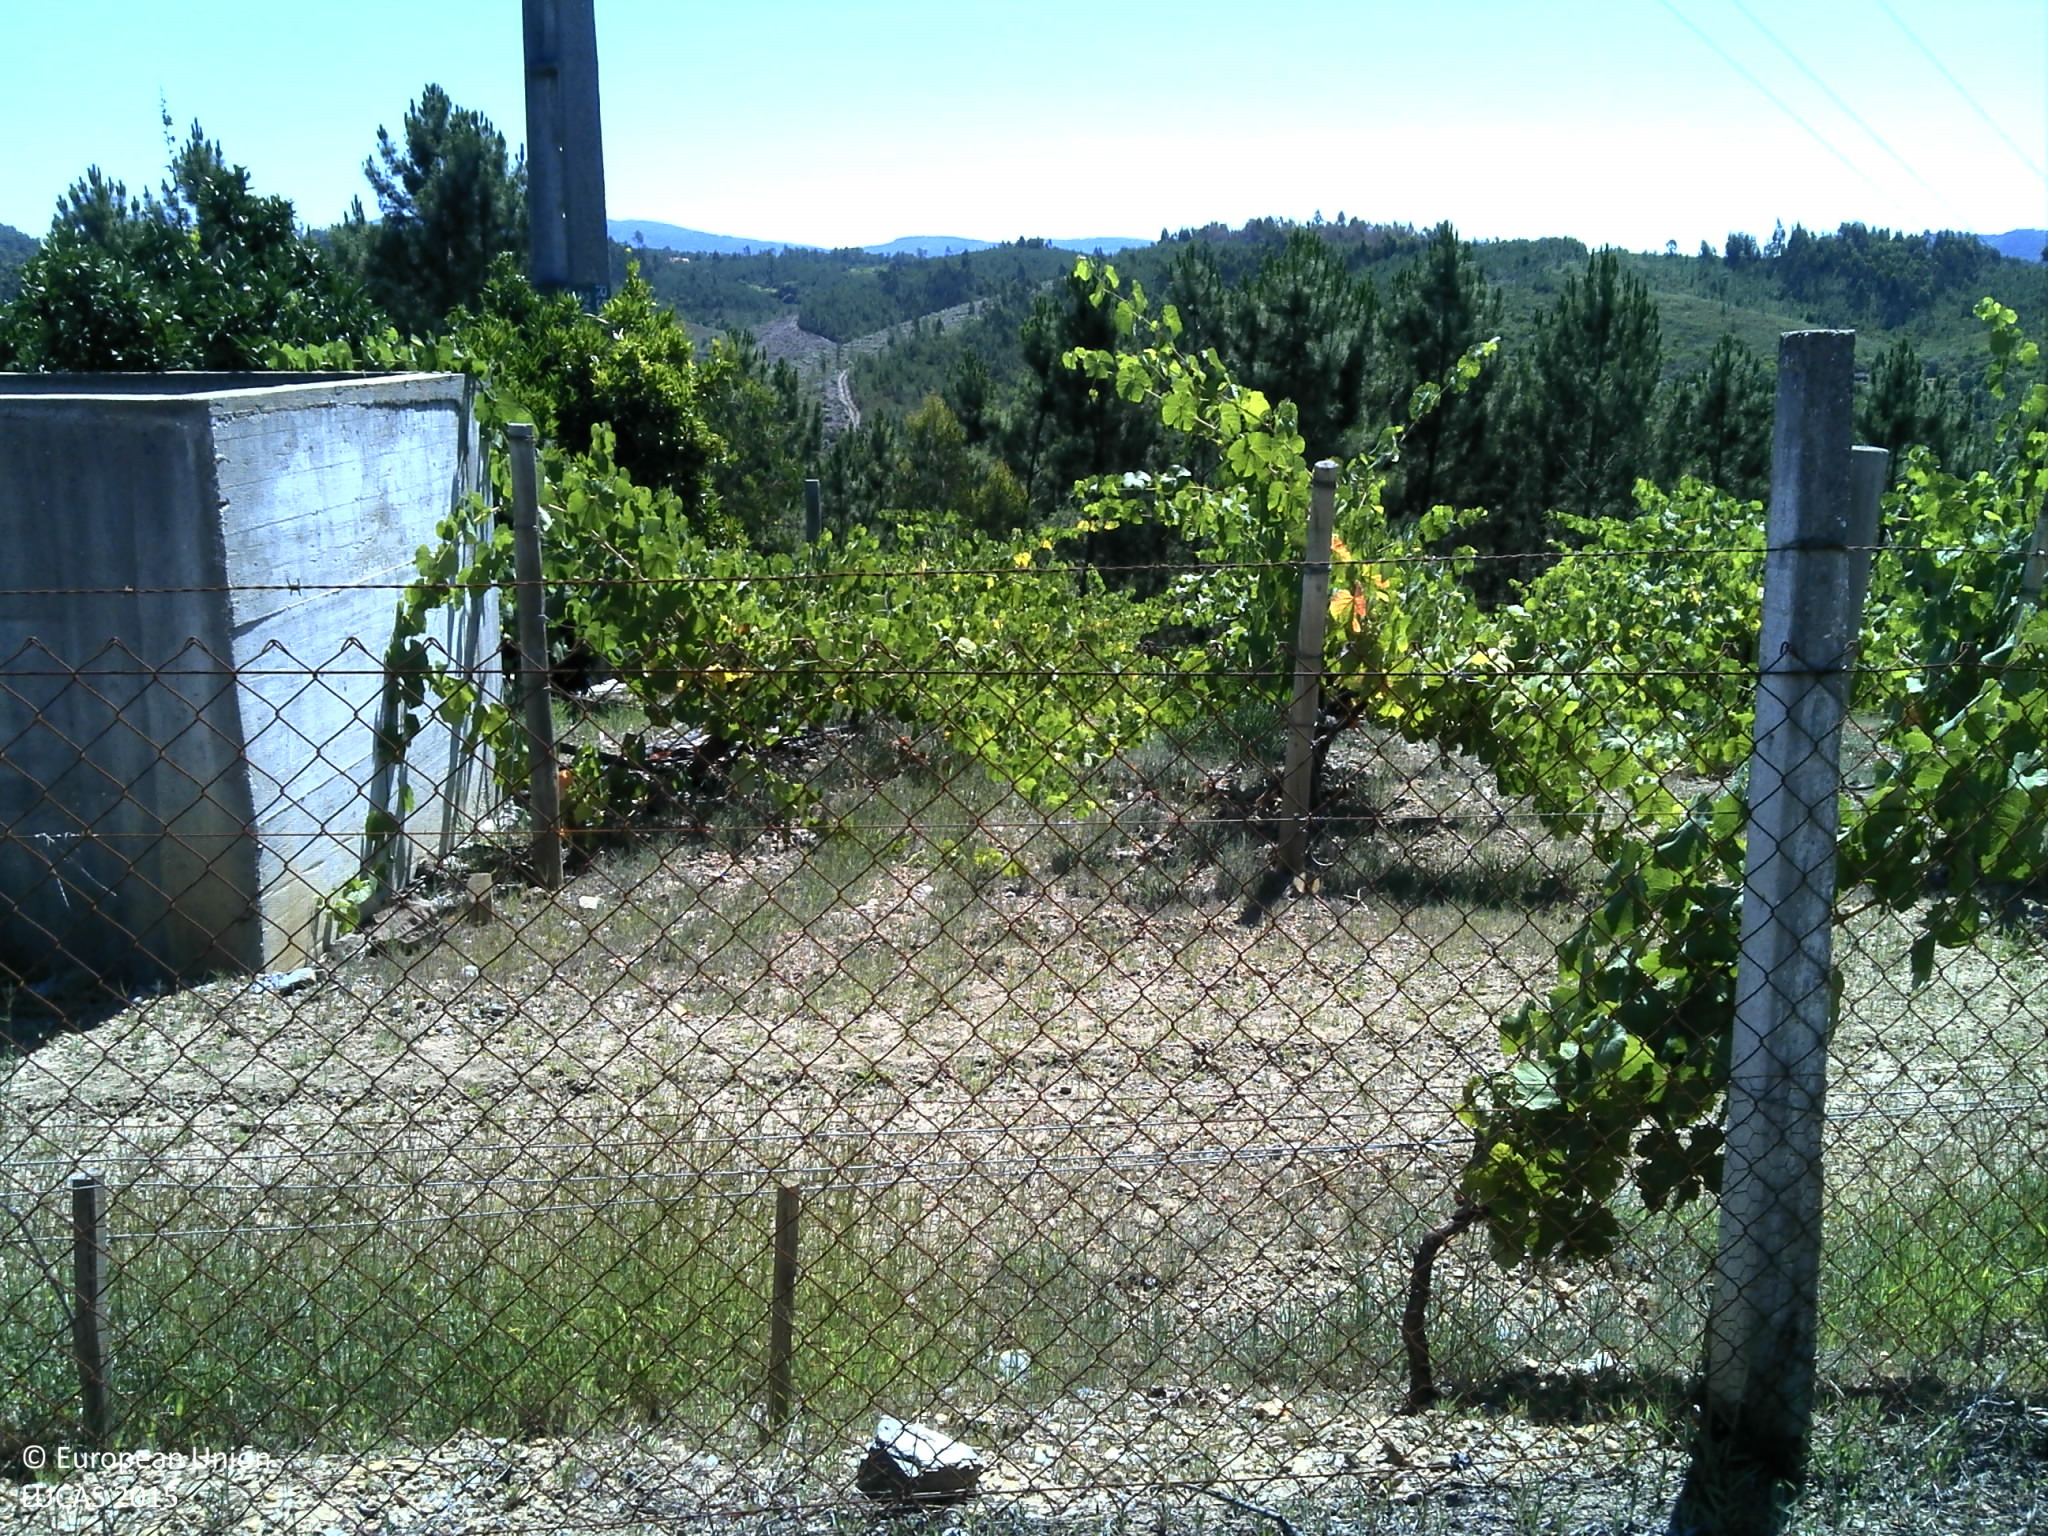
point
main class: Cropland
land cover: Vineyards
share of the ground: 25 - 50 %
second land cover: Grassland without tree/shrub cover
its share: 10 - 25 %
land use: Agriculture (excluding fallow land and kitchen gardens)
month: July
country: PT
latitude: 39.8257
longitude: -8.0955
